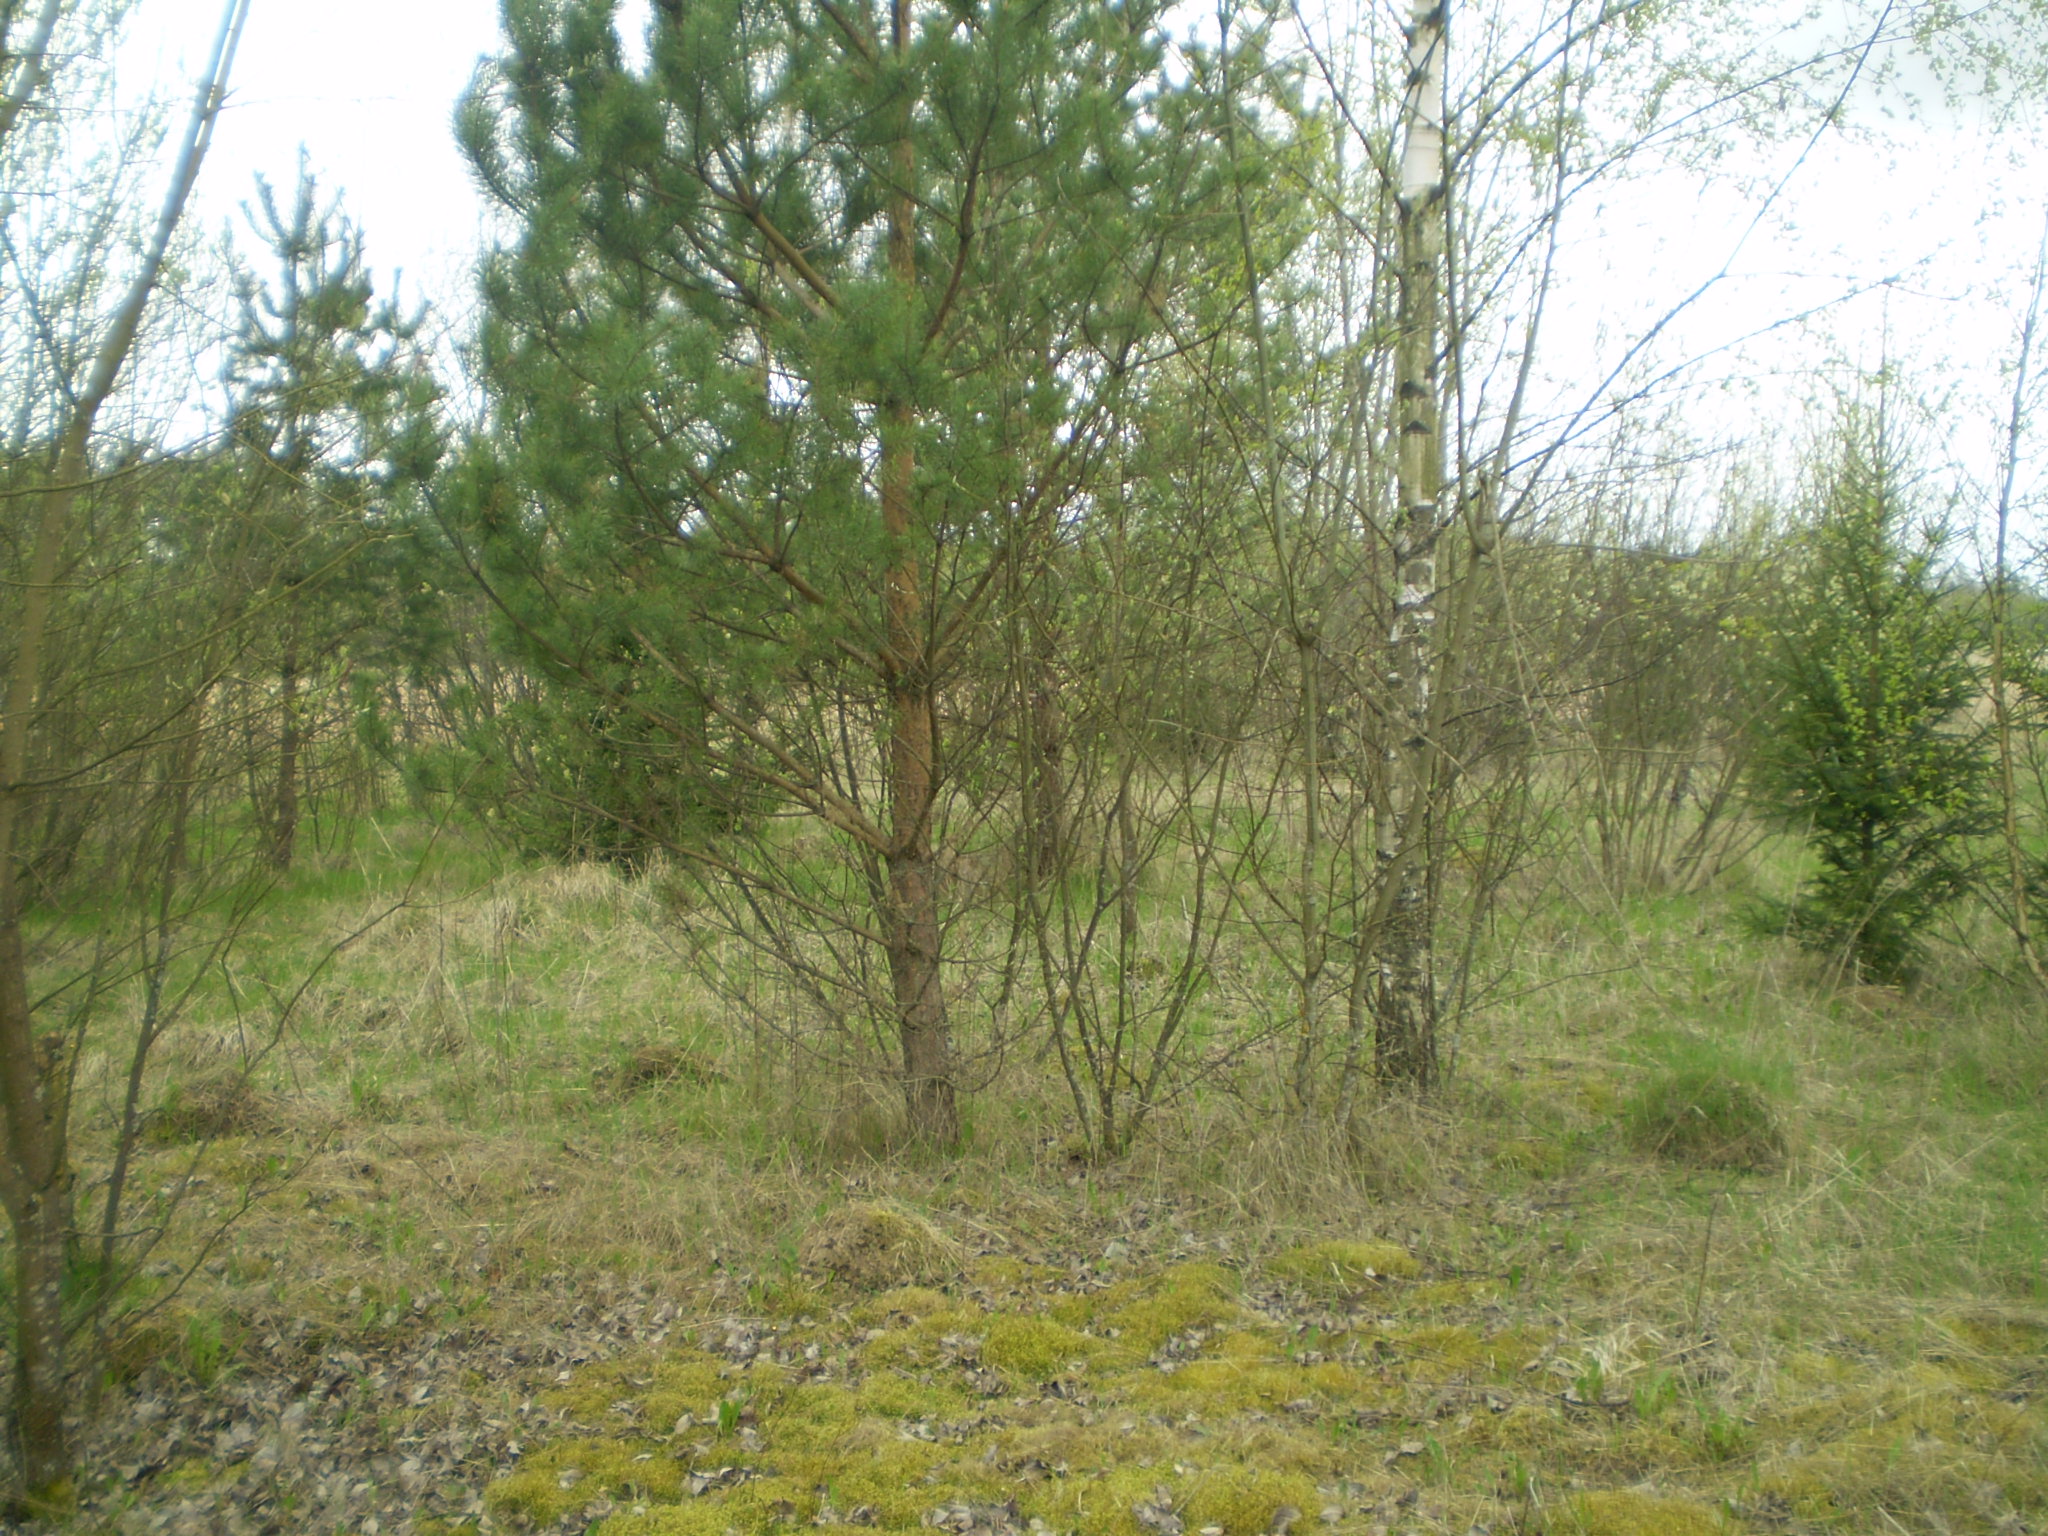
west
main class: Woodland
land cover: Other mixed woodland
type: hemiboreal forest and nemoral coniferous forest and mixed broadleaved-coniferous forest
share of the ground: > 75 %
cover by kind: broadleaved forest trees 65 %, coniferous forest trees 25 %, herbaceous plants 10 %
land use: Forestry
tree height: < 5 m
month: May
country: LT
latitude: 56.3905
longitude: 22.1525
